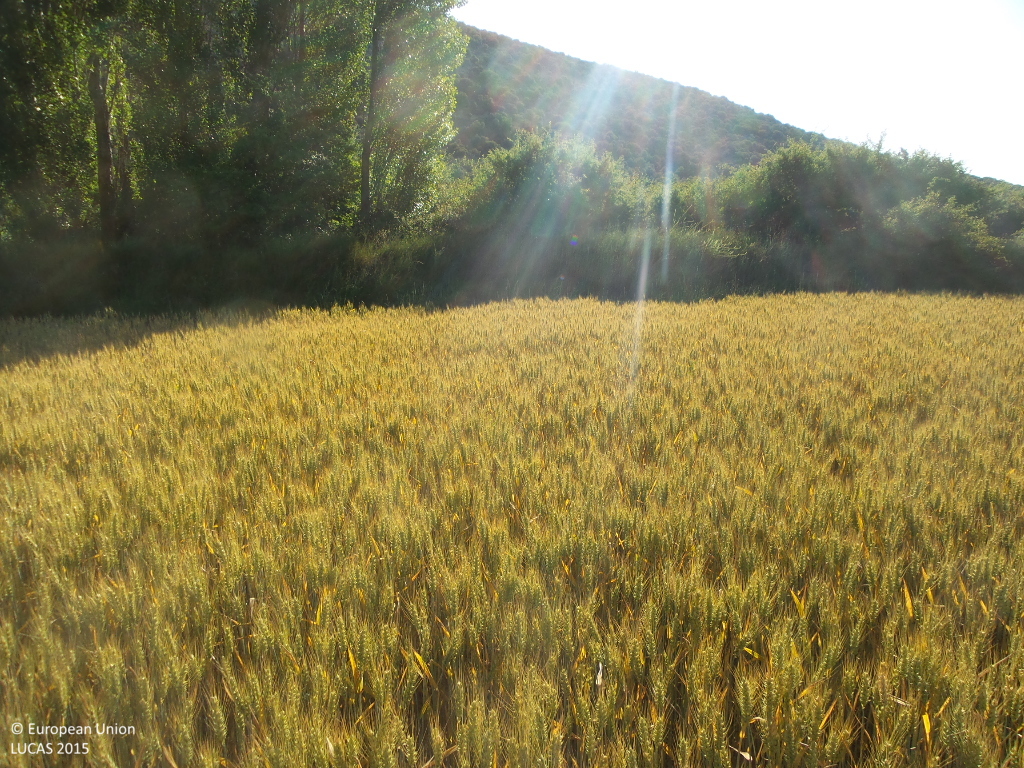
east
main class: Cropland
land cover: Common wheat
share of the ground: > 75 %
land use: Agriculture (excluding fallow land and kitchen gardens)
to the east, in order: Common wheat; Grass margins; Shrubland with sparse tree cover; Rivers and streams; Shrubland with sparse tree cover; Grass margins; Barley; Grassland with sparse tree/shrub cover; Rivers and streams; Grass margins; Barley; Electric lines; Barley; Spontaneously vegetated surfaces; Tracks; Broadleaved woodland; Shrubland without tree cover; Broadleaved woodland
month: June
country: ES
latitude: 41.3733
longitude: -2.7222
